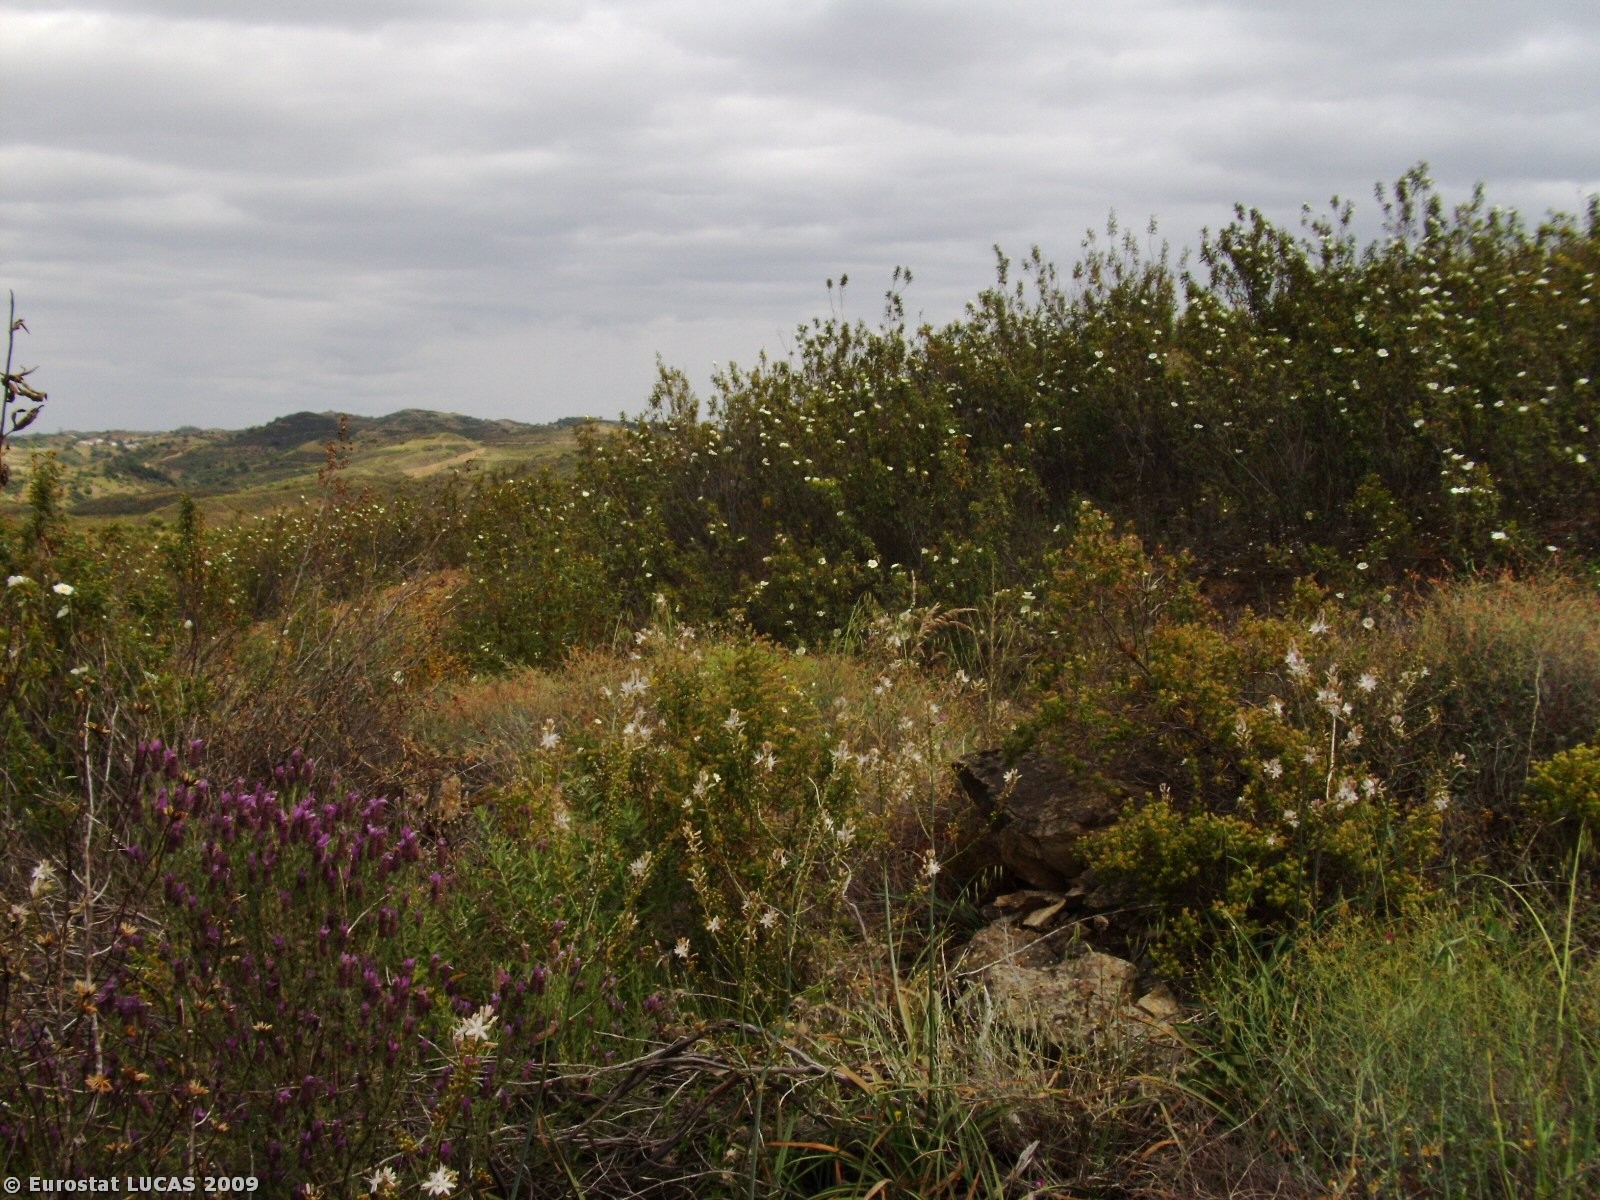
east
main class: Bare land
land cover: Bare land
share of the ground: > 75 %
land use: Unused
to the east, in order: Bare land; Shrubland without tree cover; Tracks; Shrubland without tree cover; Shrubland with sparse tree cover; Tracks; Shrubland without tree cover; Tracks; Shrubland without tree cover
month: April
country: PT
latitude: 37.3050
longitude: -7.6425
